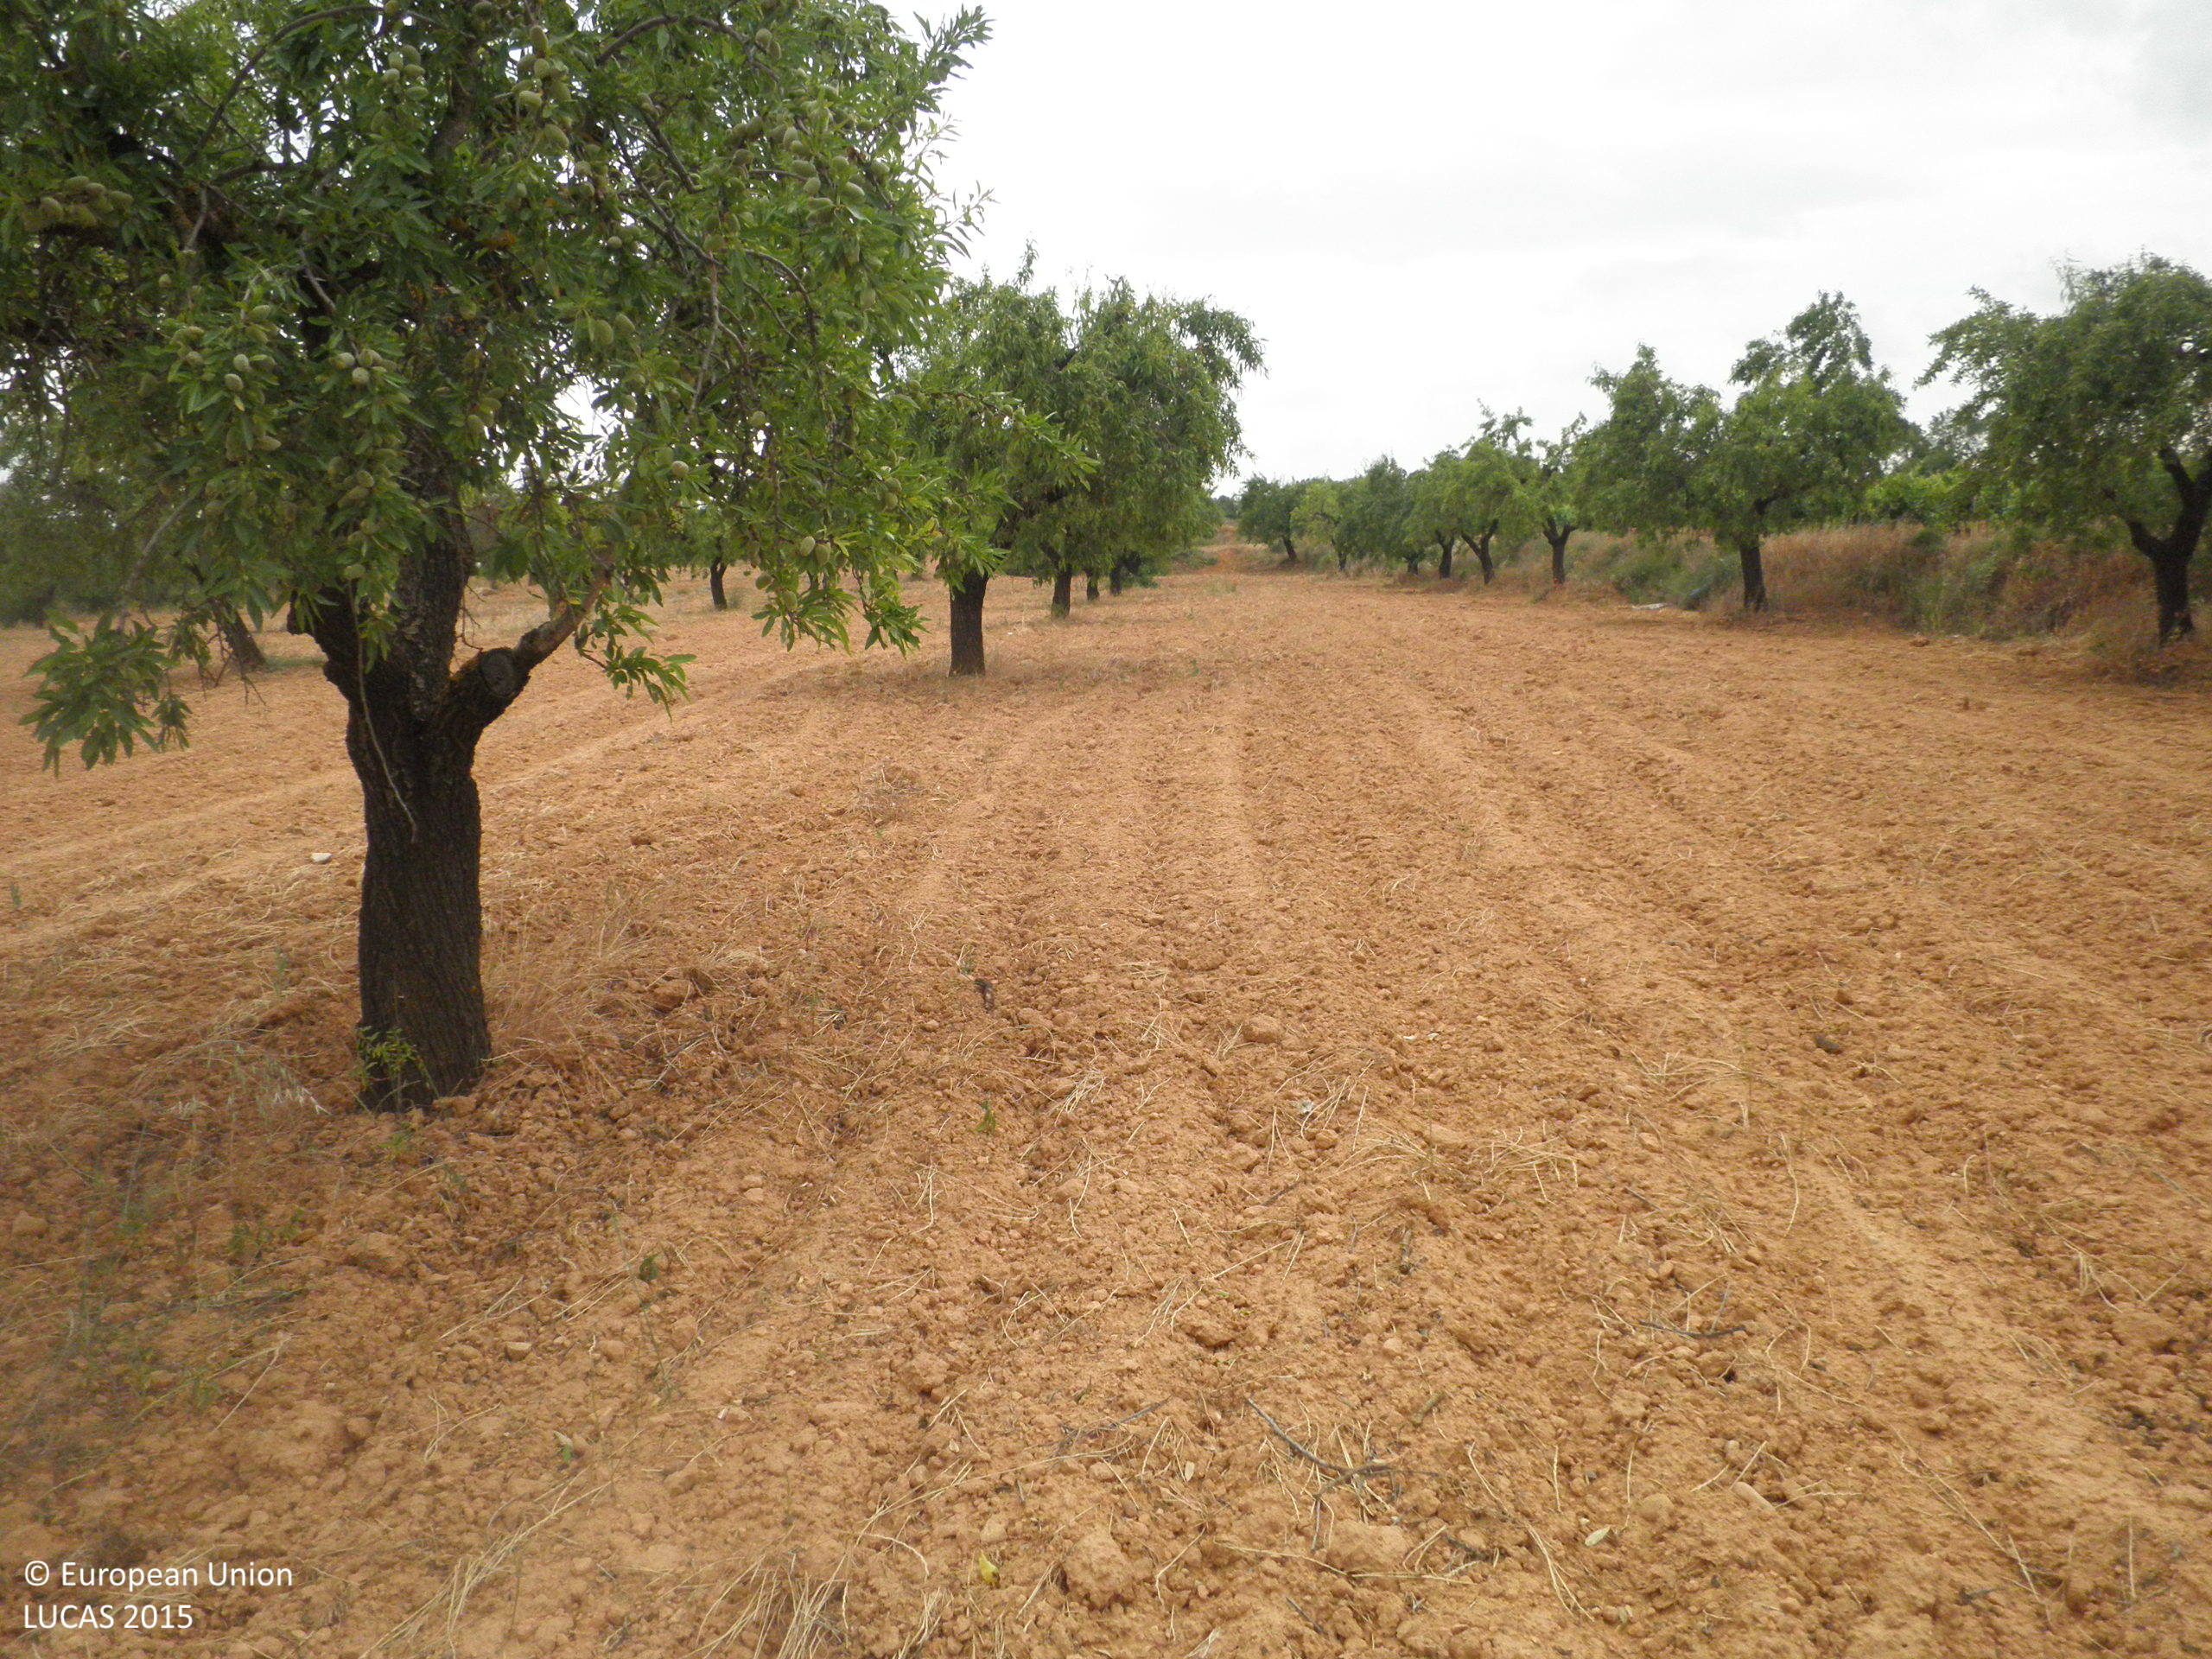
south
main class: Cropland
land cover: Nuts trees
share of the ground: < 10 %
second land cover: Other bare soil
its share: > 75 %
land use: Agriculture (excluding fallow land and kitchen gardens)
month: June
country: ES
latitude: 39.5395
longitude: -1.6059
